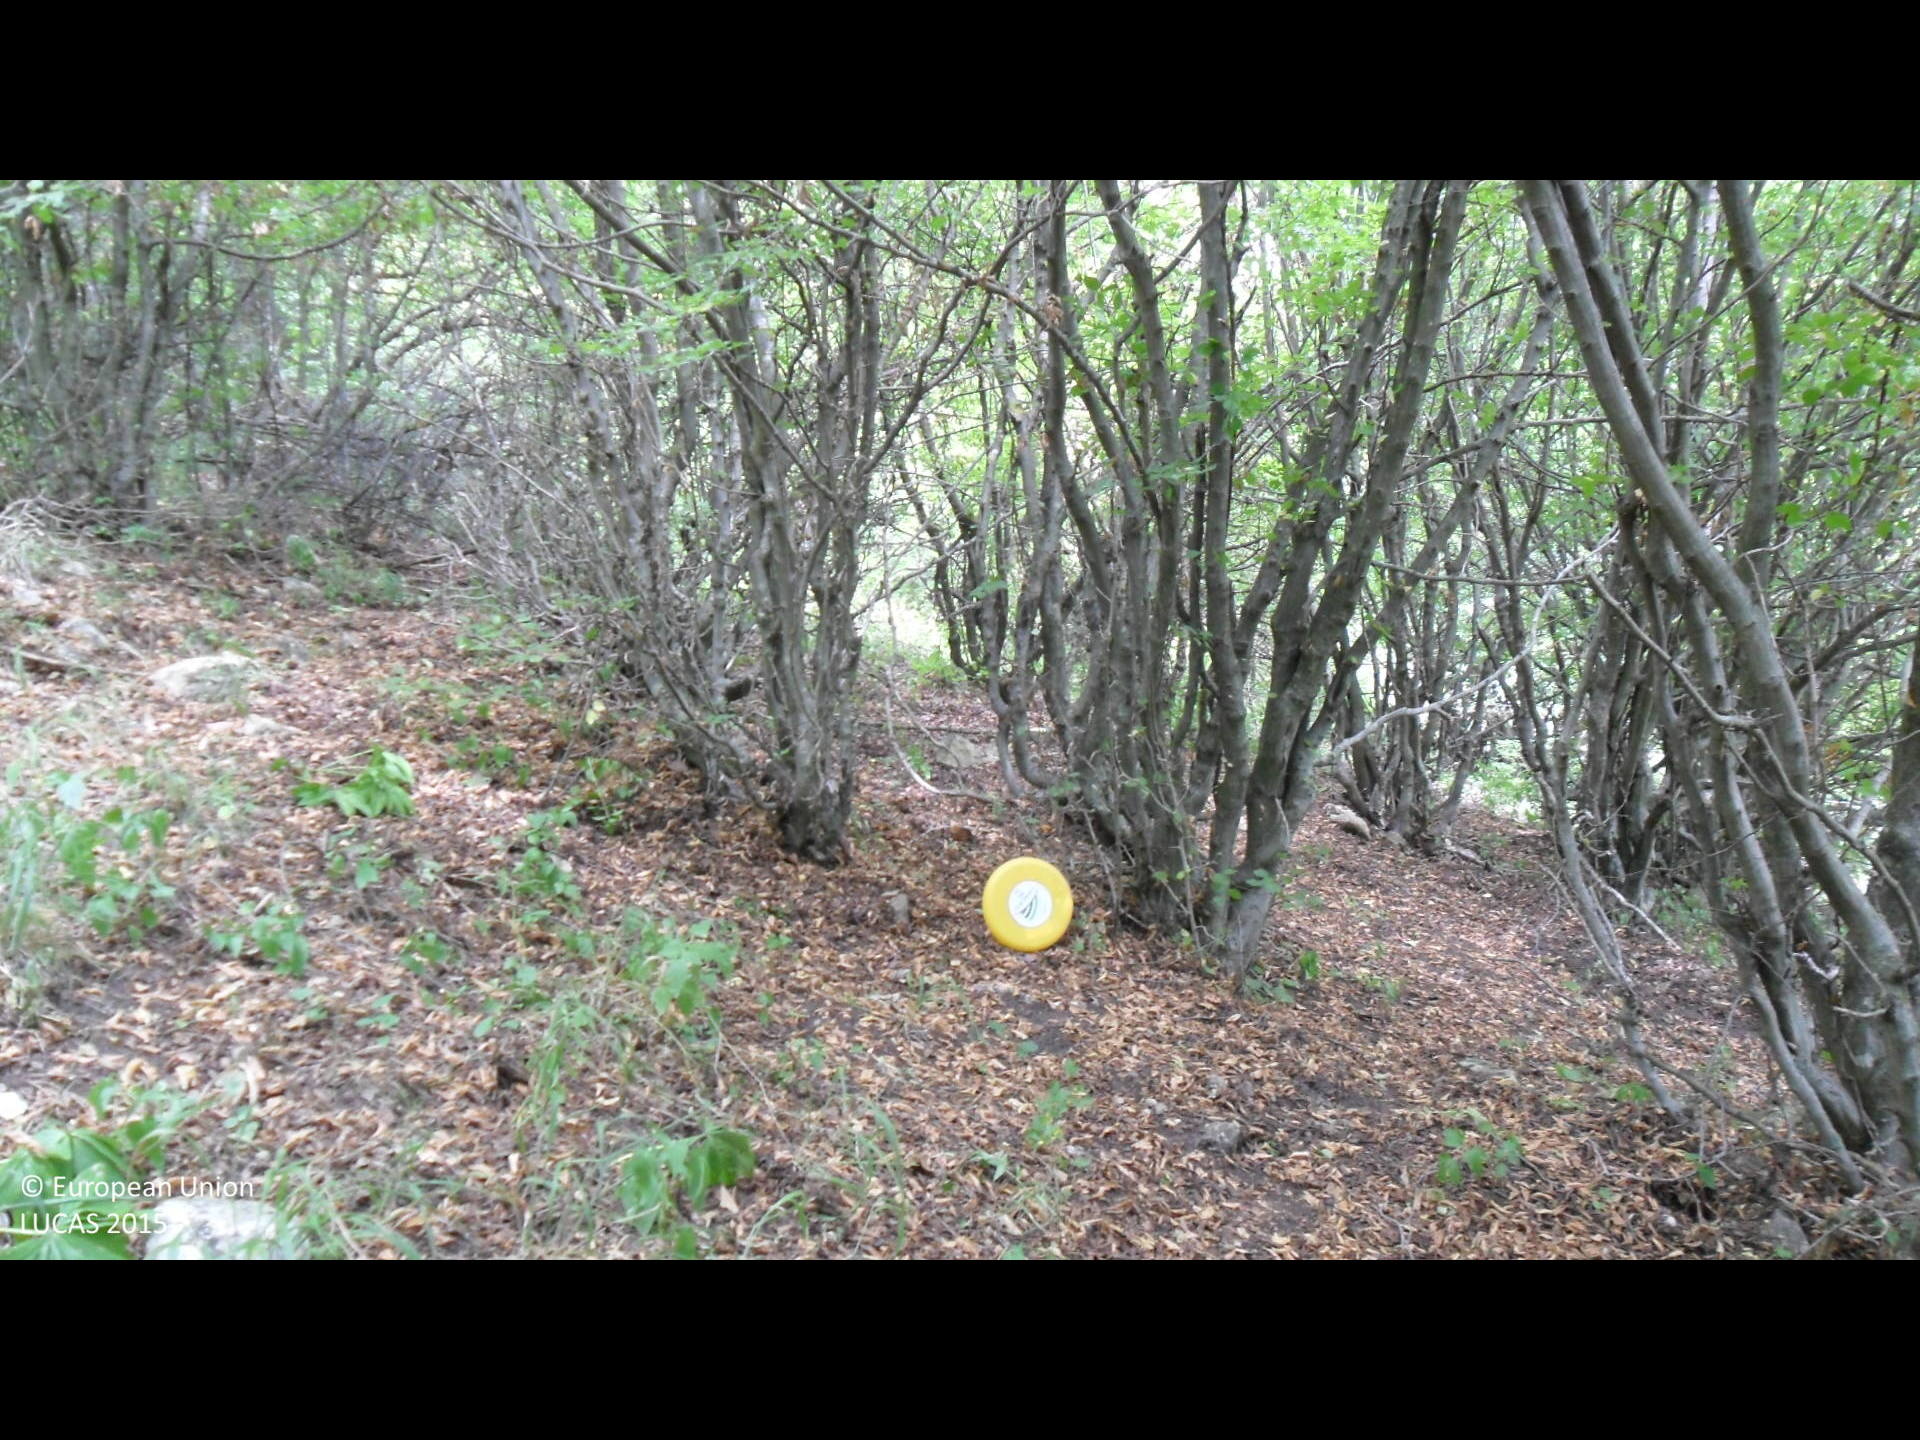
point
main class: Woodland
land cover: Broadleaved woodland
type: mesophytic deciduous forest
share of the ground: 50 - 75 %
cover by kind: broadleaved forest trees 100 %
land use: Forestry
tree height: > 5 m
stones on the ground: 10 - 25 %
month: August
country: BG
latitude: 43.5137
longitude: 26.1657
